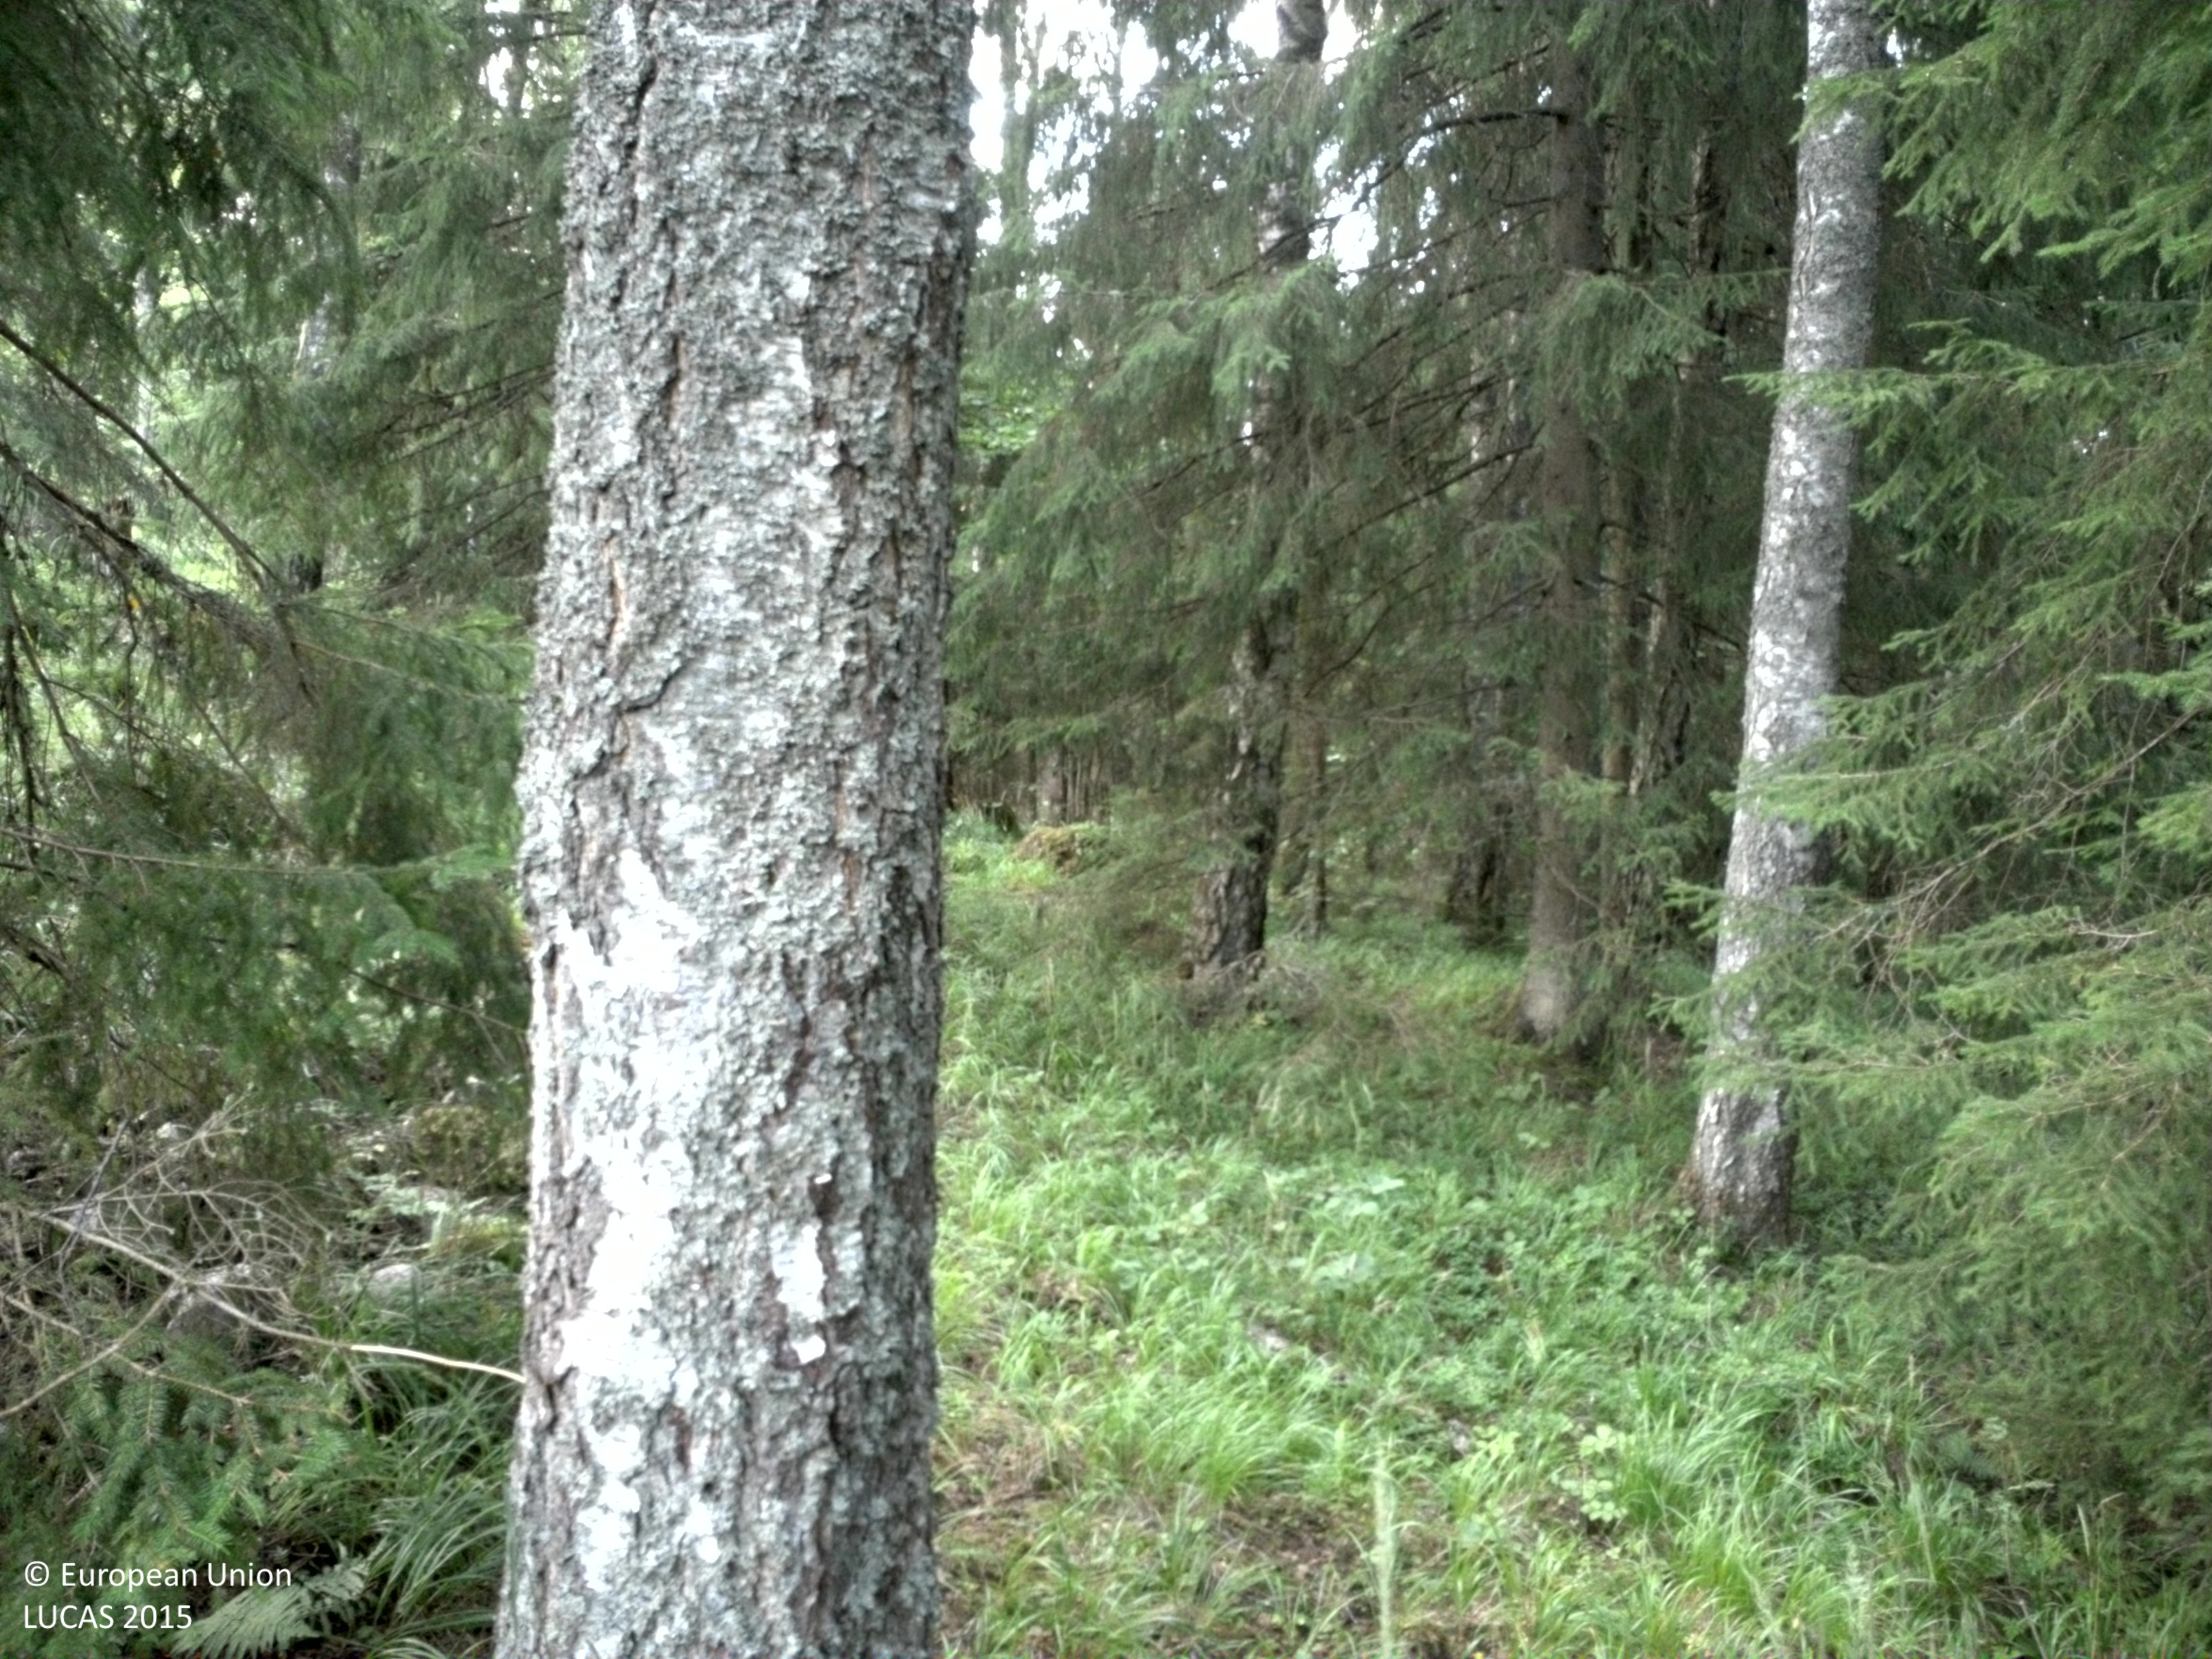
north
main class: Woodland
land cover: Spruce dominated mixed woodland
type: boreal forest
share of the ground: 50 - 75 %
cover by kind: coniferous forest trees 40 %, broadleaved forest trees 25 %, herbaceous plants 25 %, shrubs 10 %
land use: Forestry
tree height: > 5 m
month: July
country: SE
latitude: 58.5469
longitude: 14.3061
